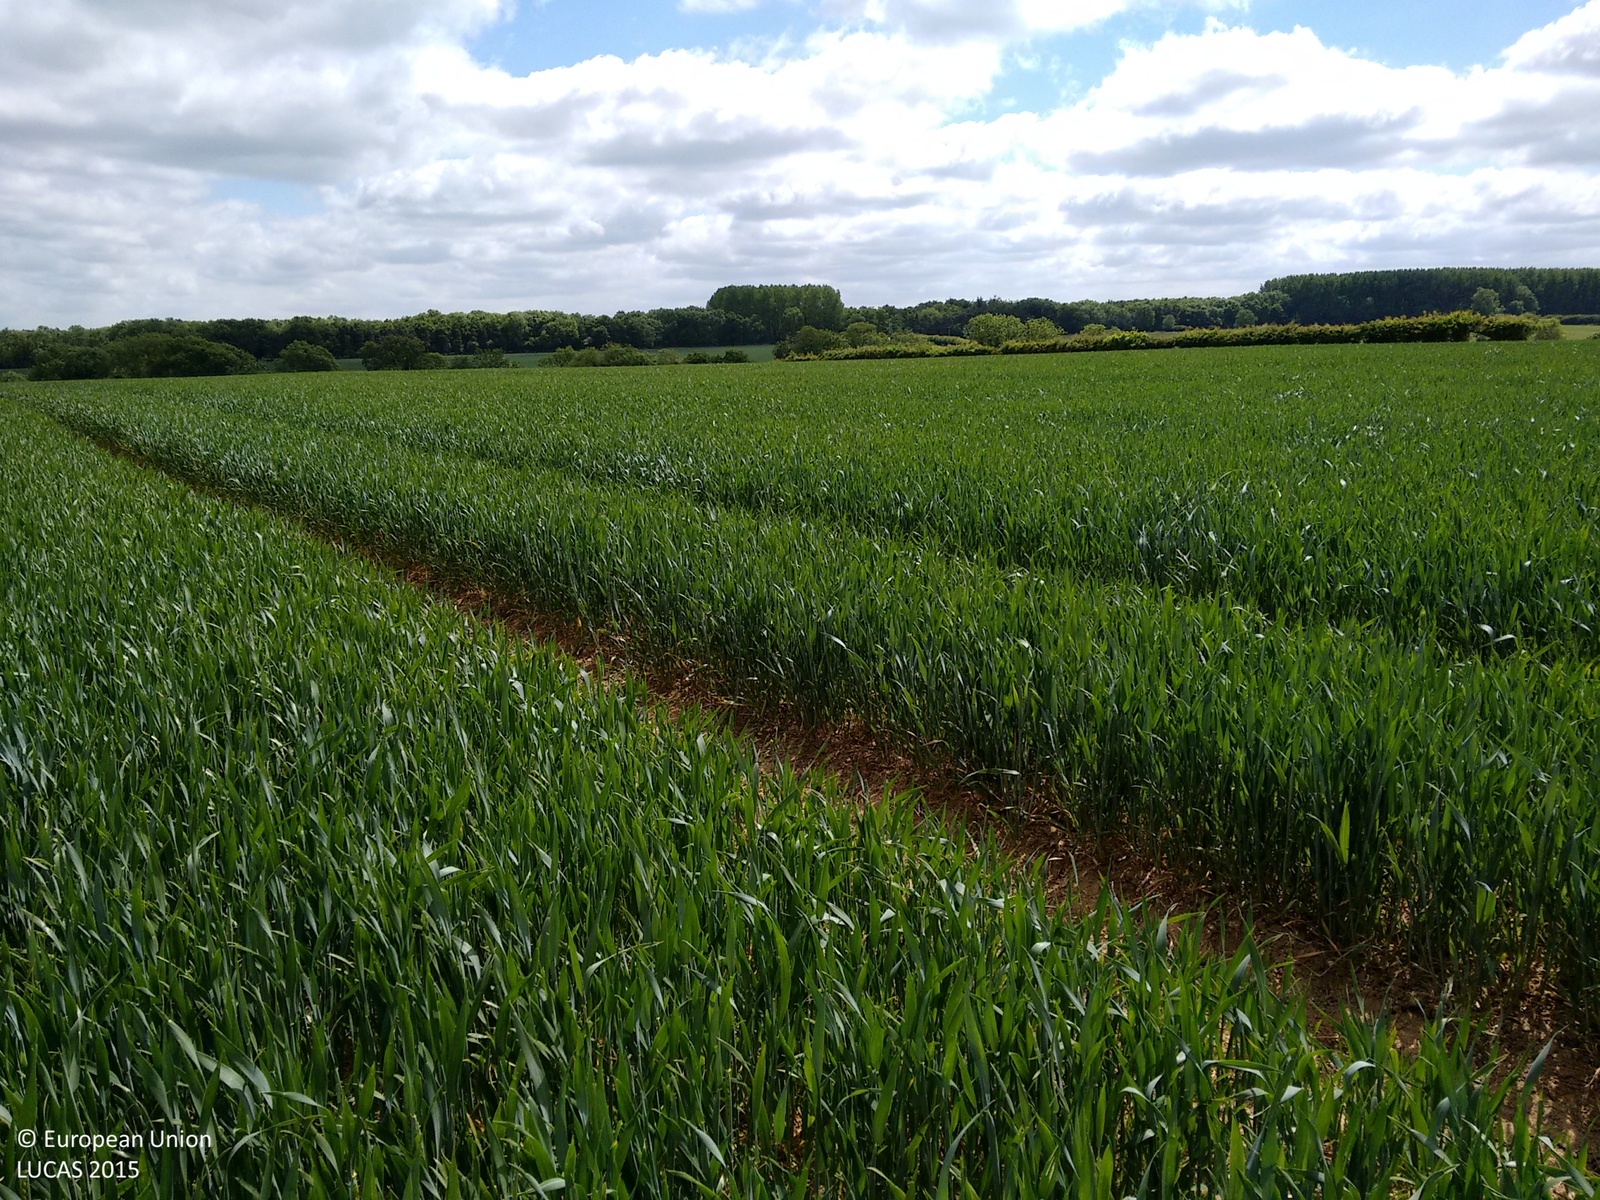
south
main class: Cropland
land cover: Common wheat
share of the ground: > 75 %
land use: Agriculture (excluding fallow land and kitchen gardens)
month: June
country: GB
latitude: 52.7918
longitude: -0.5825
